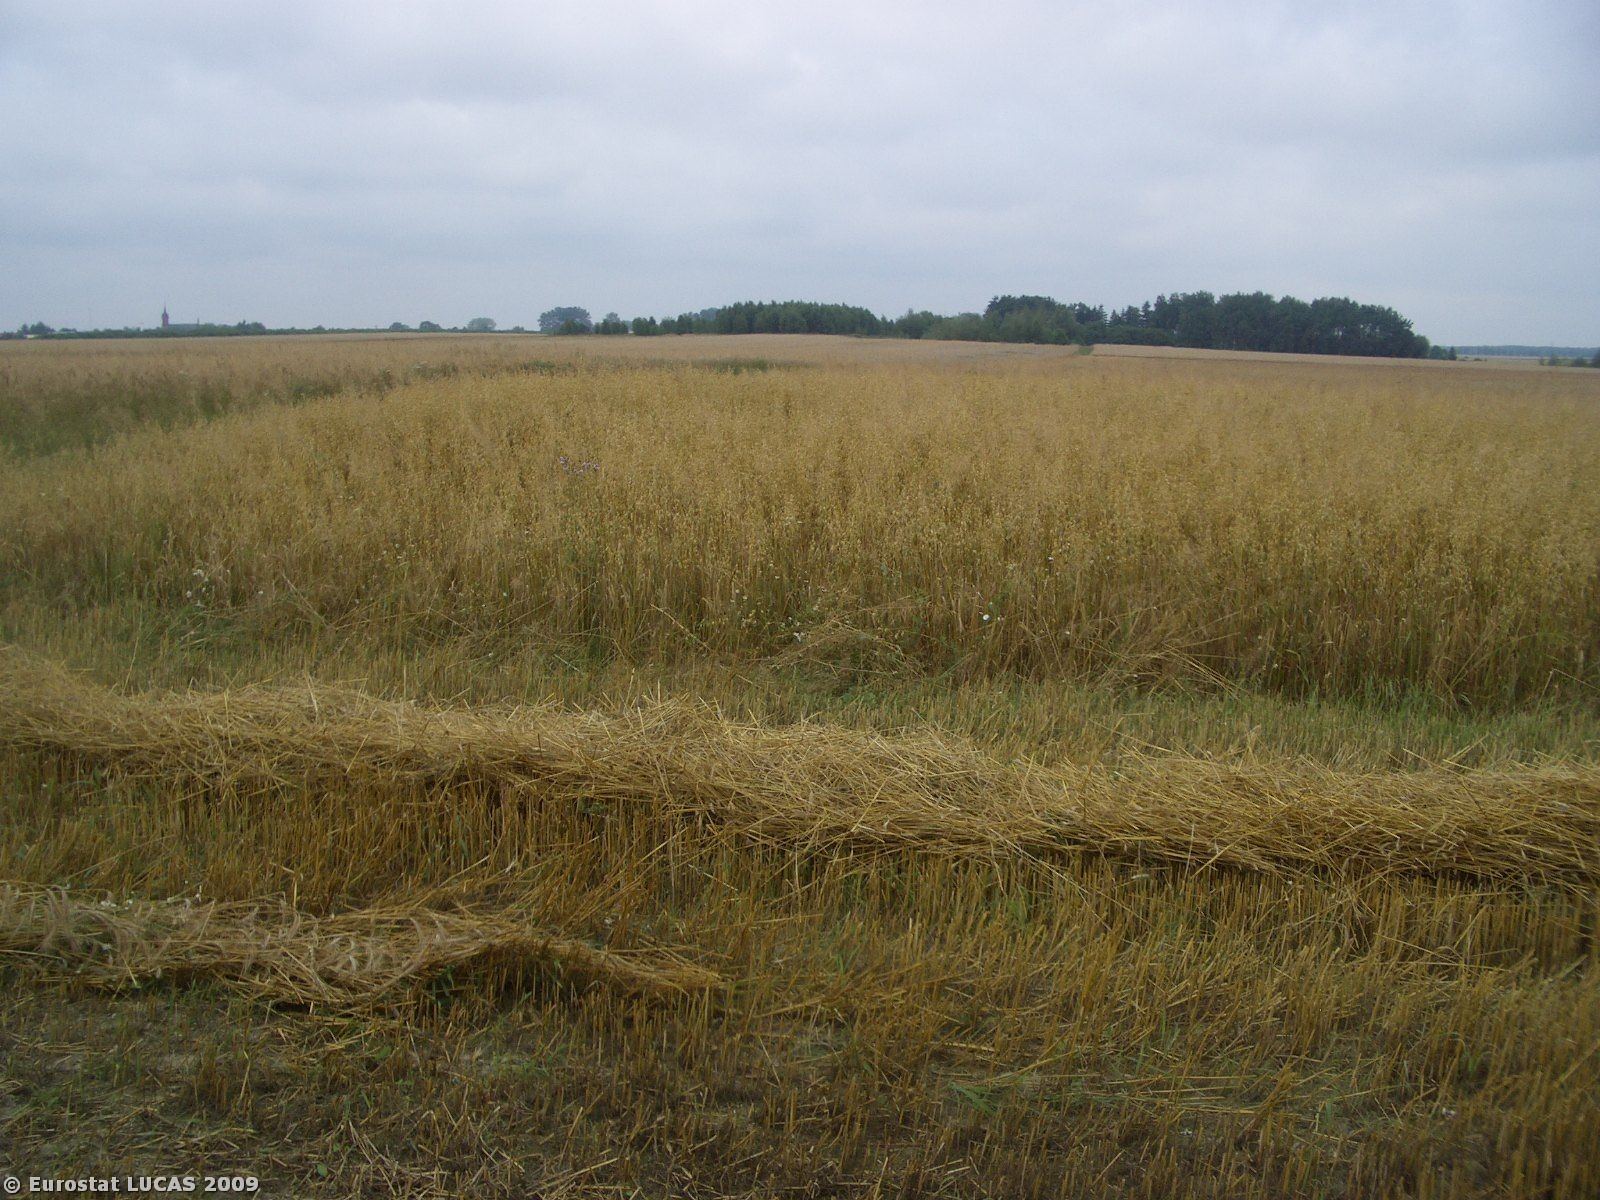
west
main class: Cropland
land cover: Triticale
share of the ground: < 10 %
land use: Agriculture (excluding fallow land and kitchen gardens)
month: July
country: PL
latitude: 51.8080
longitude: 22.9684
